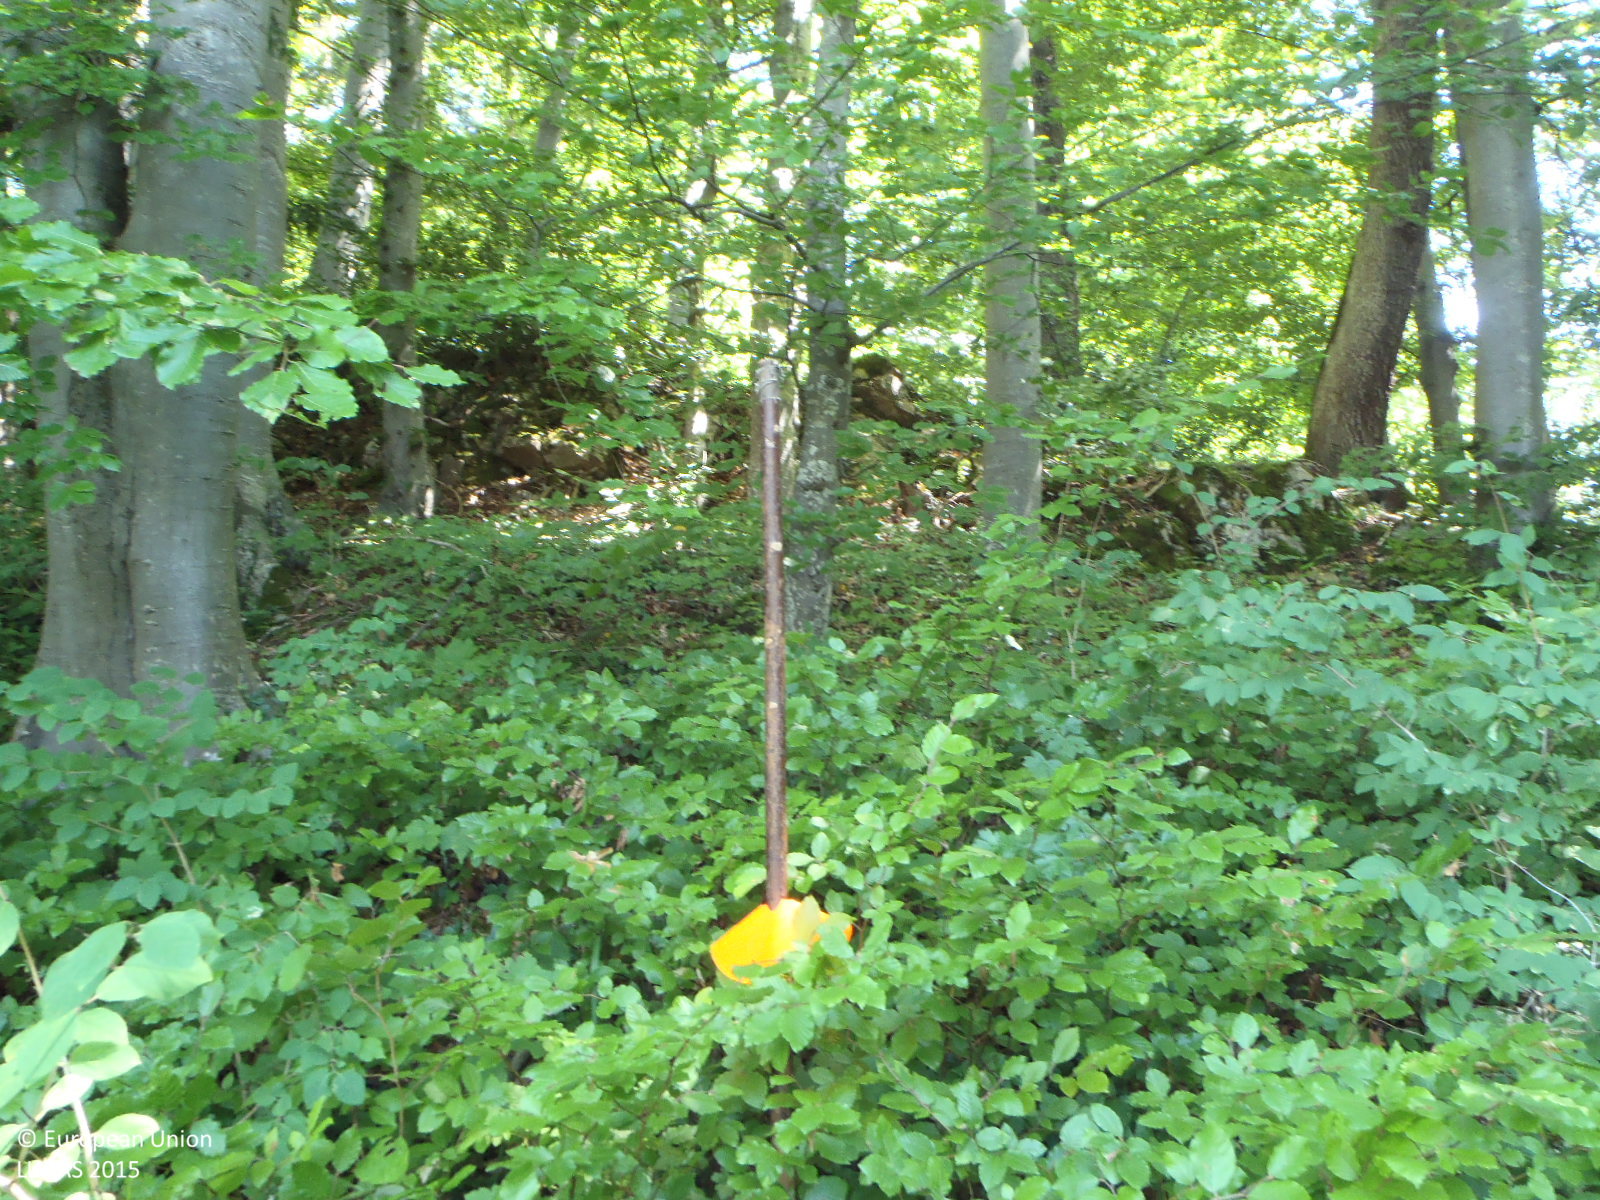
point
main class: Woodland
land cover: Broadleaved woodland
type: mountainous beech forest
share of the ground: > 75 %
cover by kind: broadleaved forest trees 80 %, coniferous forest trees 10 %, herbaceous plants 10 %
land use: Forestry
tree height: > 5 m
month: July
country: AT
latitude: 47.3411
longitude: 9.6694
